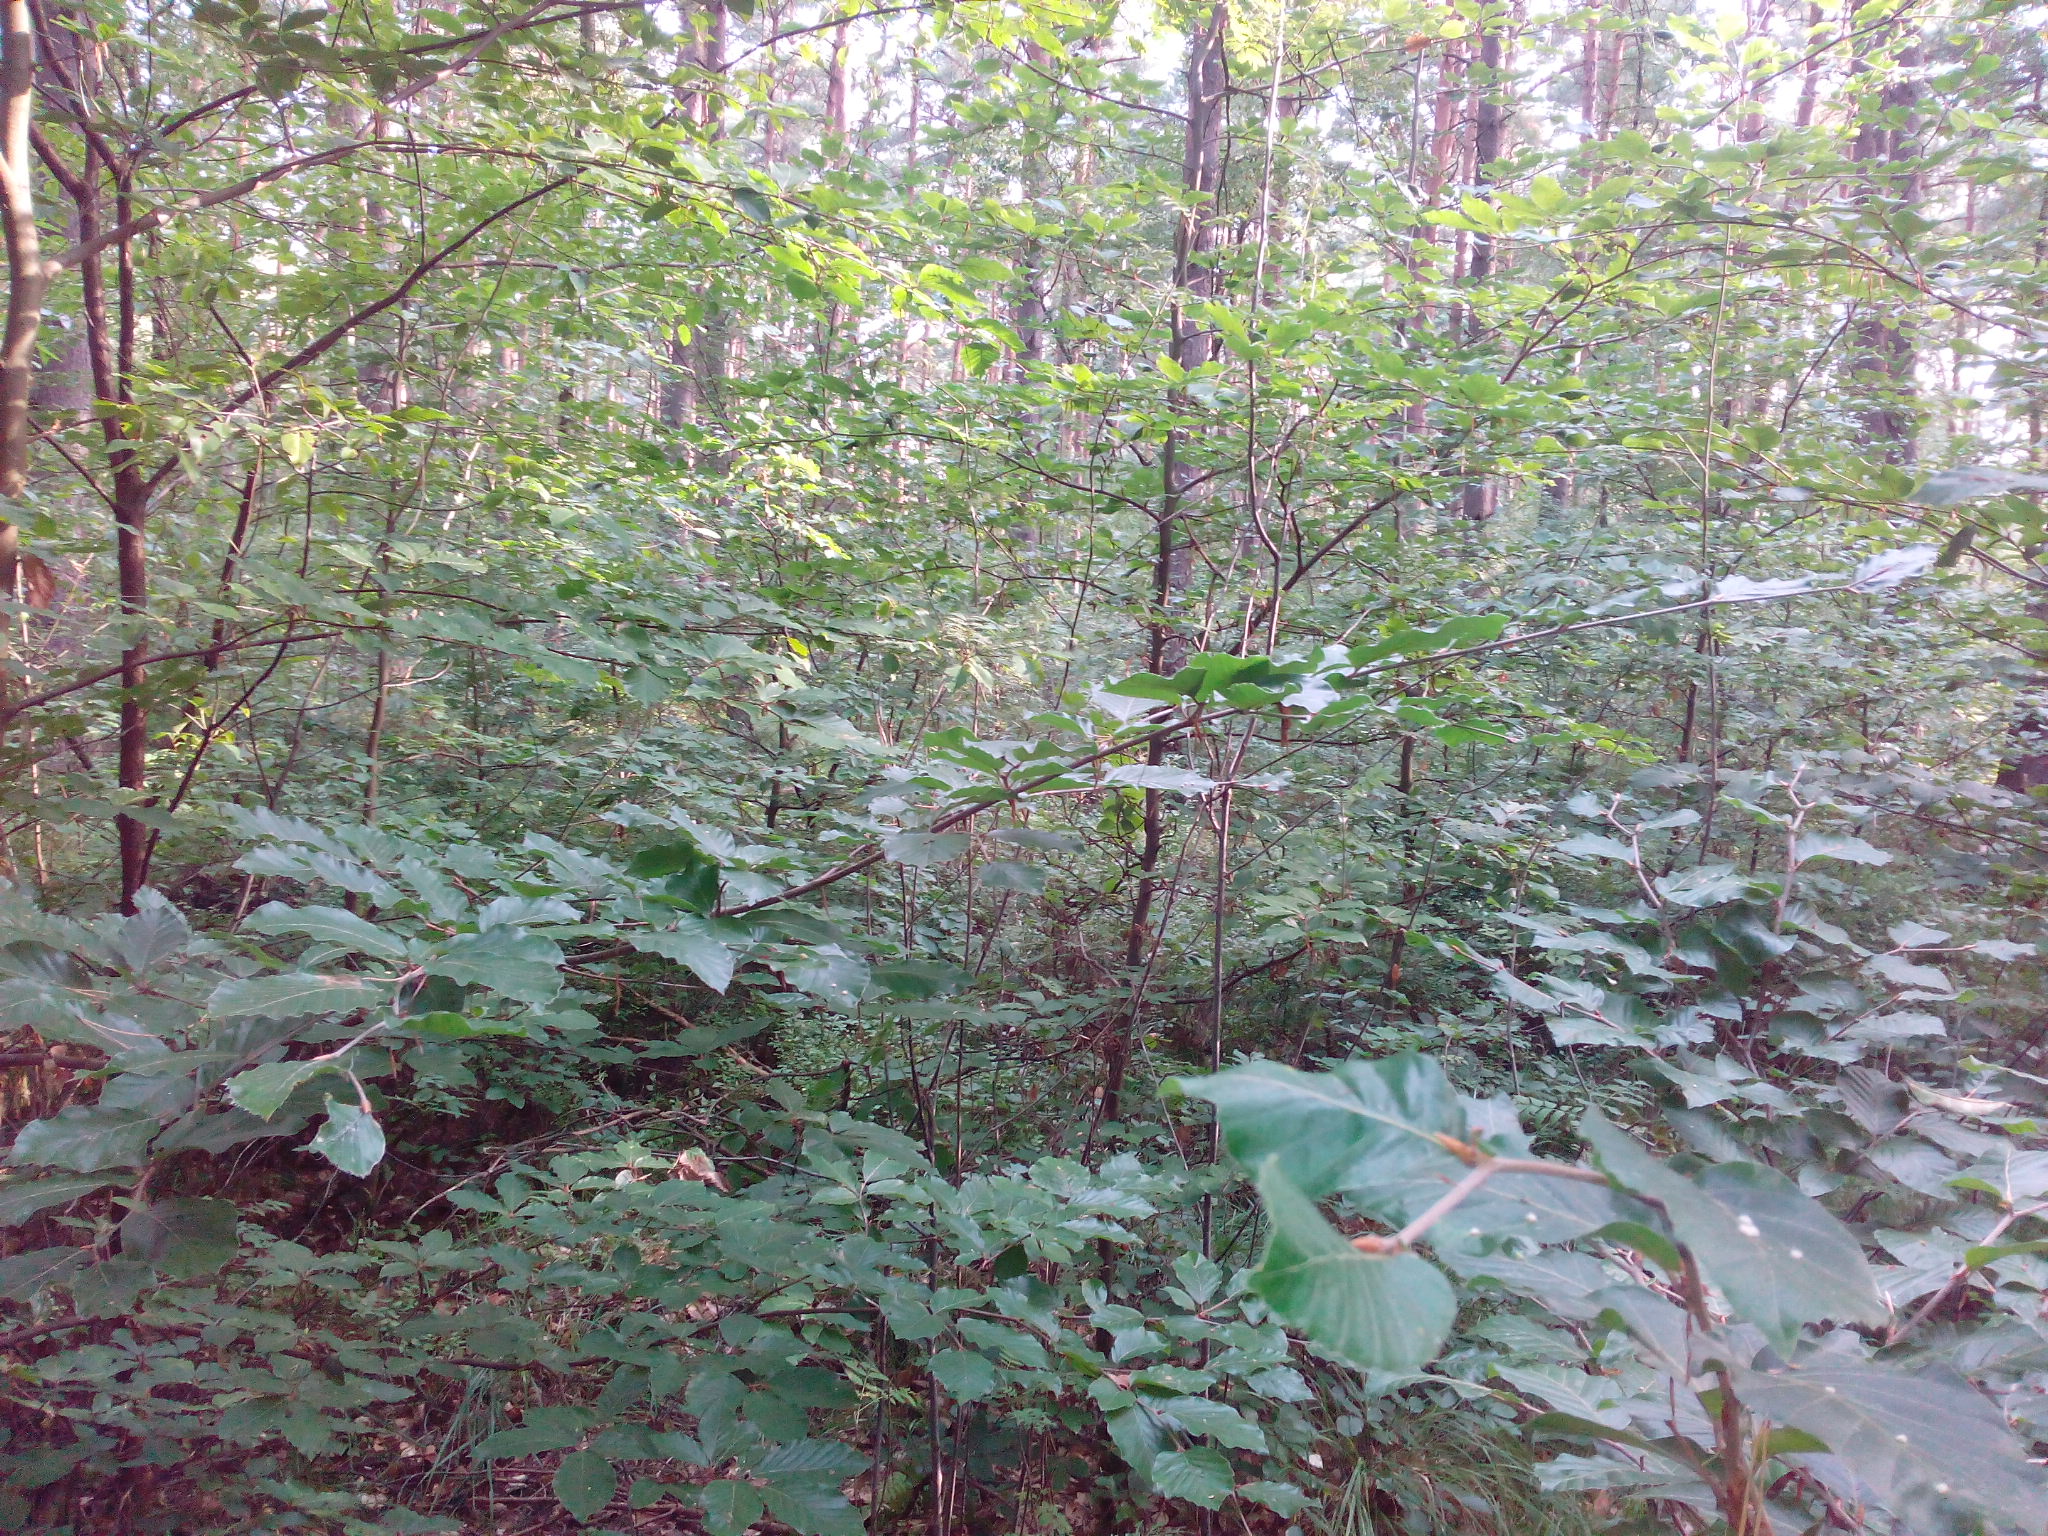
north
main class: Woodland
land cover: Pine dominated mixed woodland
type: hemiboreal forest and nemoral coniferous forest and mixed broadleaved-coniferous forest
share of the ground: > 75 %
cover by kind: coniferous forest trees 45 %, broadleaved forest trees 45 %, shrubs 5 %, herbaceous plants 5 %
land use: Forestry
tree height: > 5 m
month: August
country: DE
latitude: 52.5752
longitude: 9.9262
